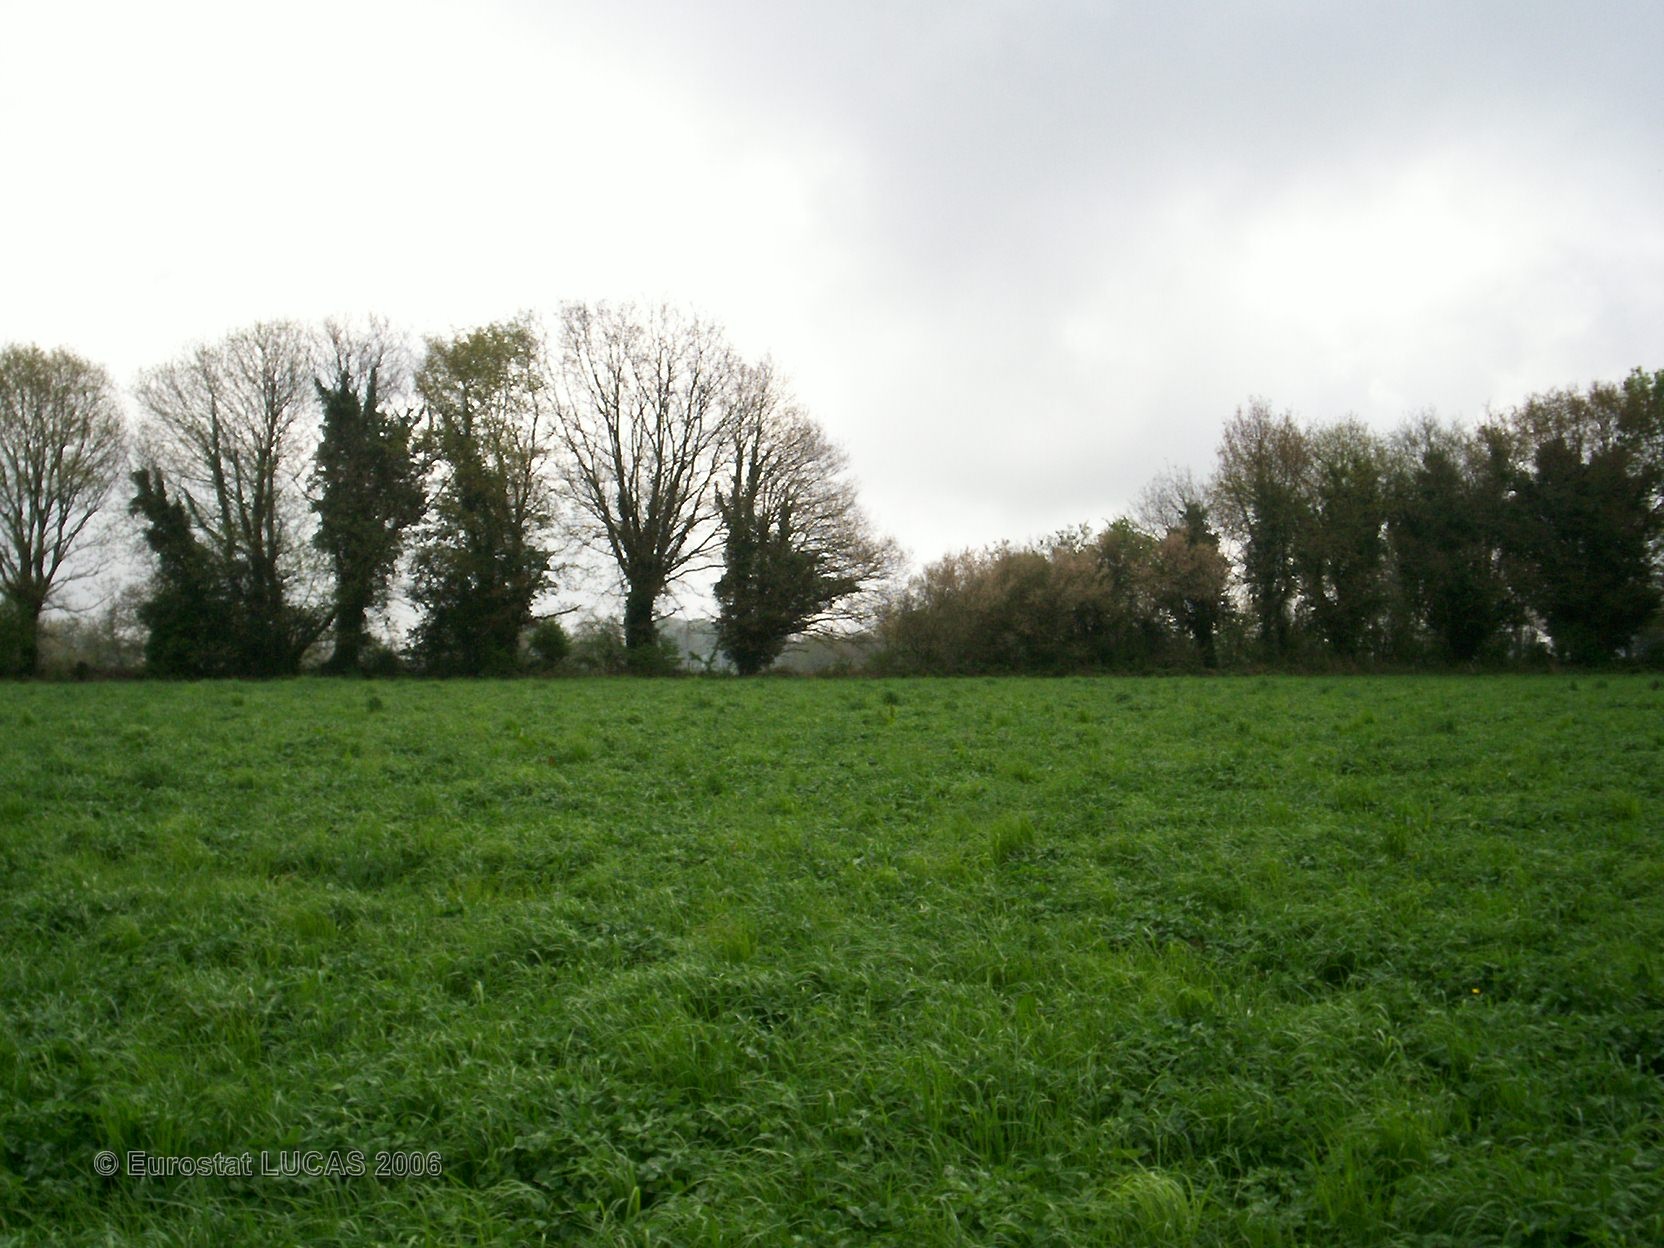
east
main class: Grassland
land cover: Grassland without tree/shrub cover
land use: Agriculture (excluding fallow land and kitchen gardens)
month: May
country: FR
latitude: 47.7646
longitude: -2.8050
